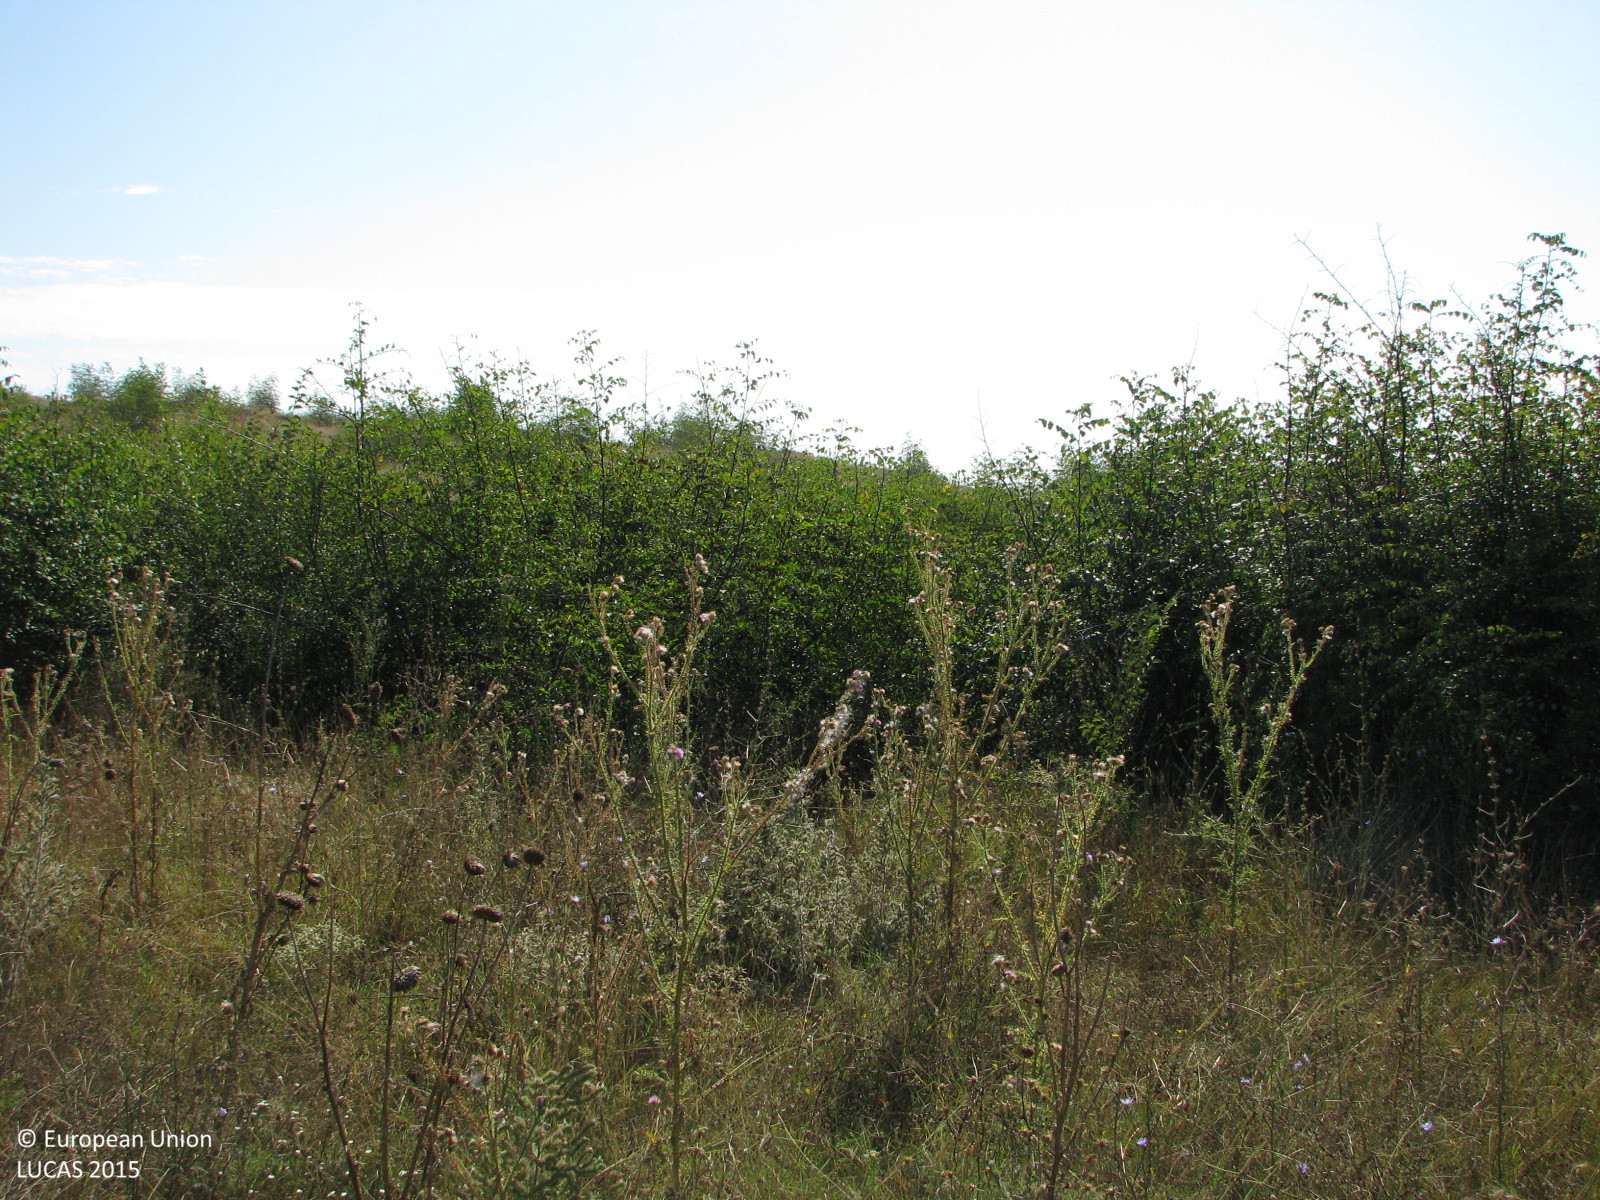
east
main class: Shrubland
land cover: Shrubland without tree cover
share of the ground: 50 - 75 %
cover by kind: shrubs 60 %, herbaceous plants 40 %
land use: Agriculture (excluding fallow land and kitchen gardens)
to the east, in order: Shrubland without tree cover; Grassland with sparse tree/shrub cover; Shrubland without tree cover
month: September
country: BG
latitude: 42.5493
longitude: 26.2224
